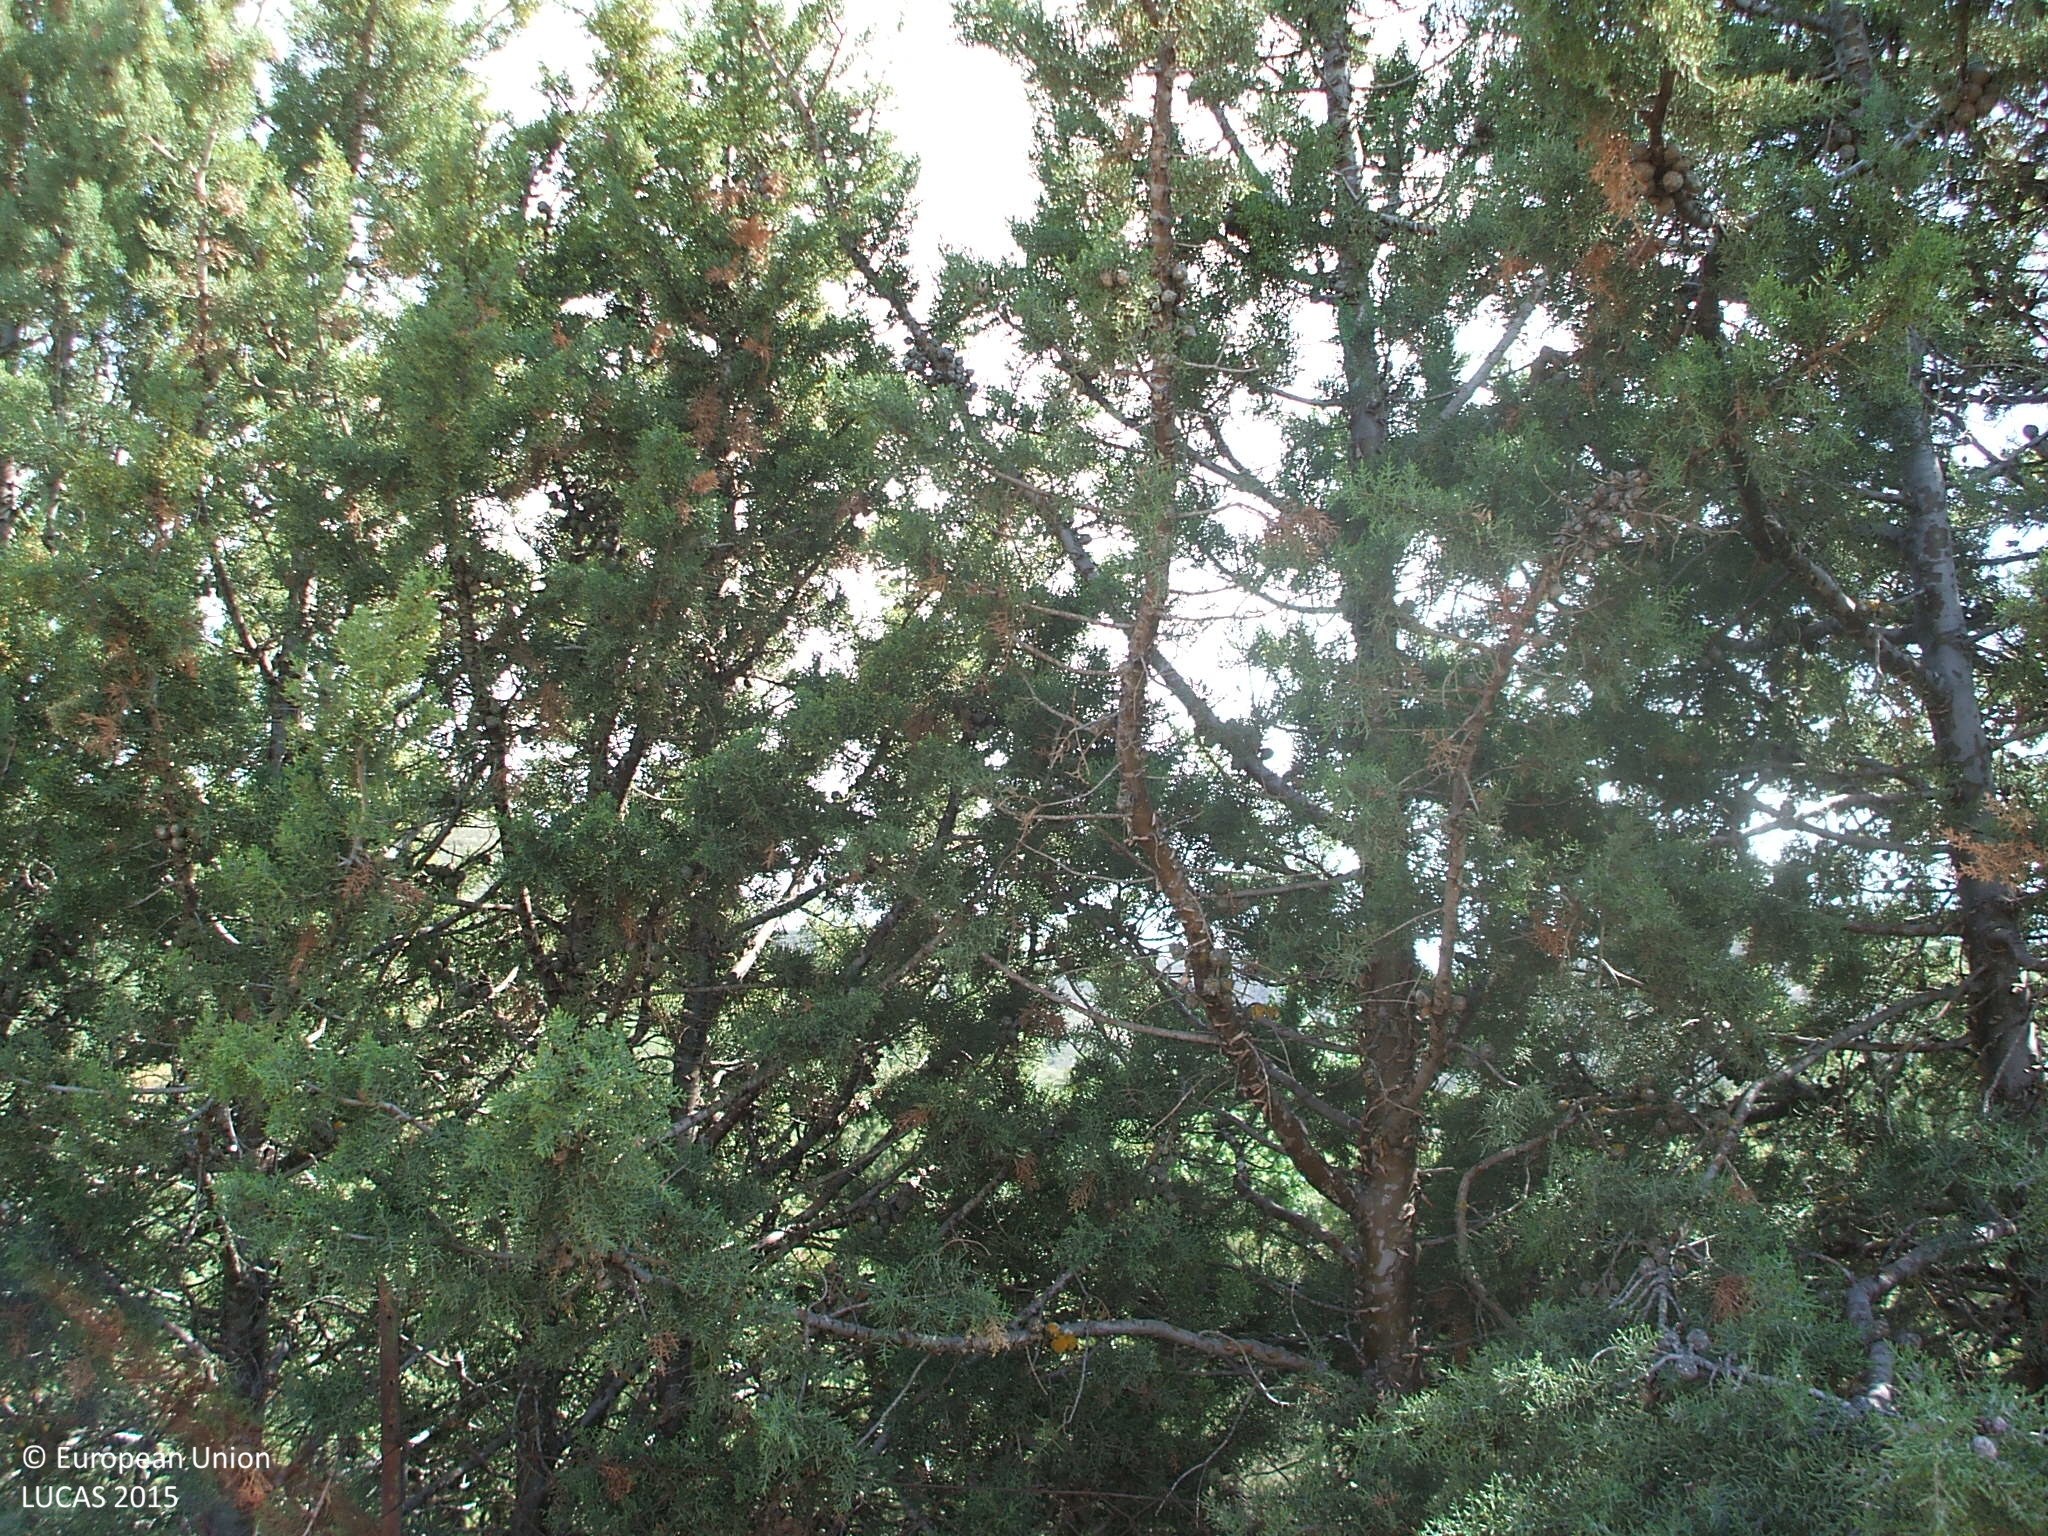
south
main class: Grassland
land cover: Grassland with sparse tree/shrub cover
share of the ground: > 75 %
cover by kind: herbaceous plants 95 %, broadleaved forest trees 5 %
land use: Abandoned areas
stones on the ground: 25 - 50 %
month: May
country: ES
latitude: 40.9274
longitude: -2.9188
